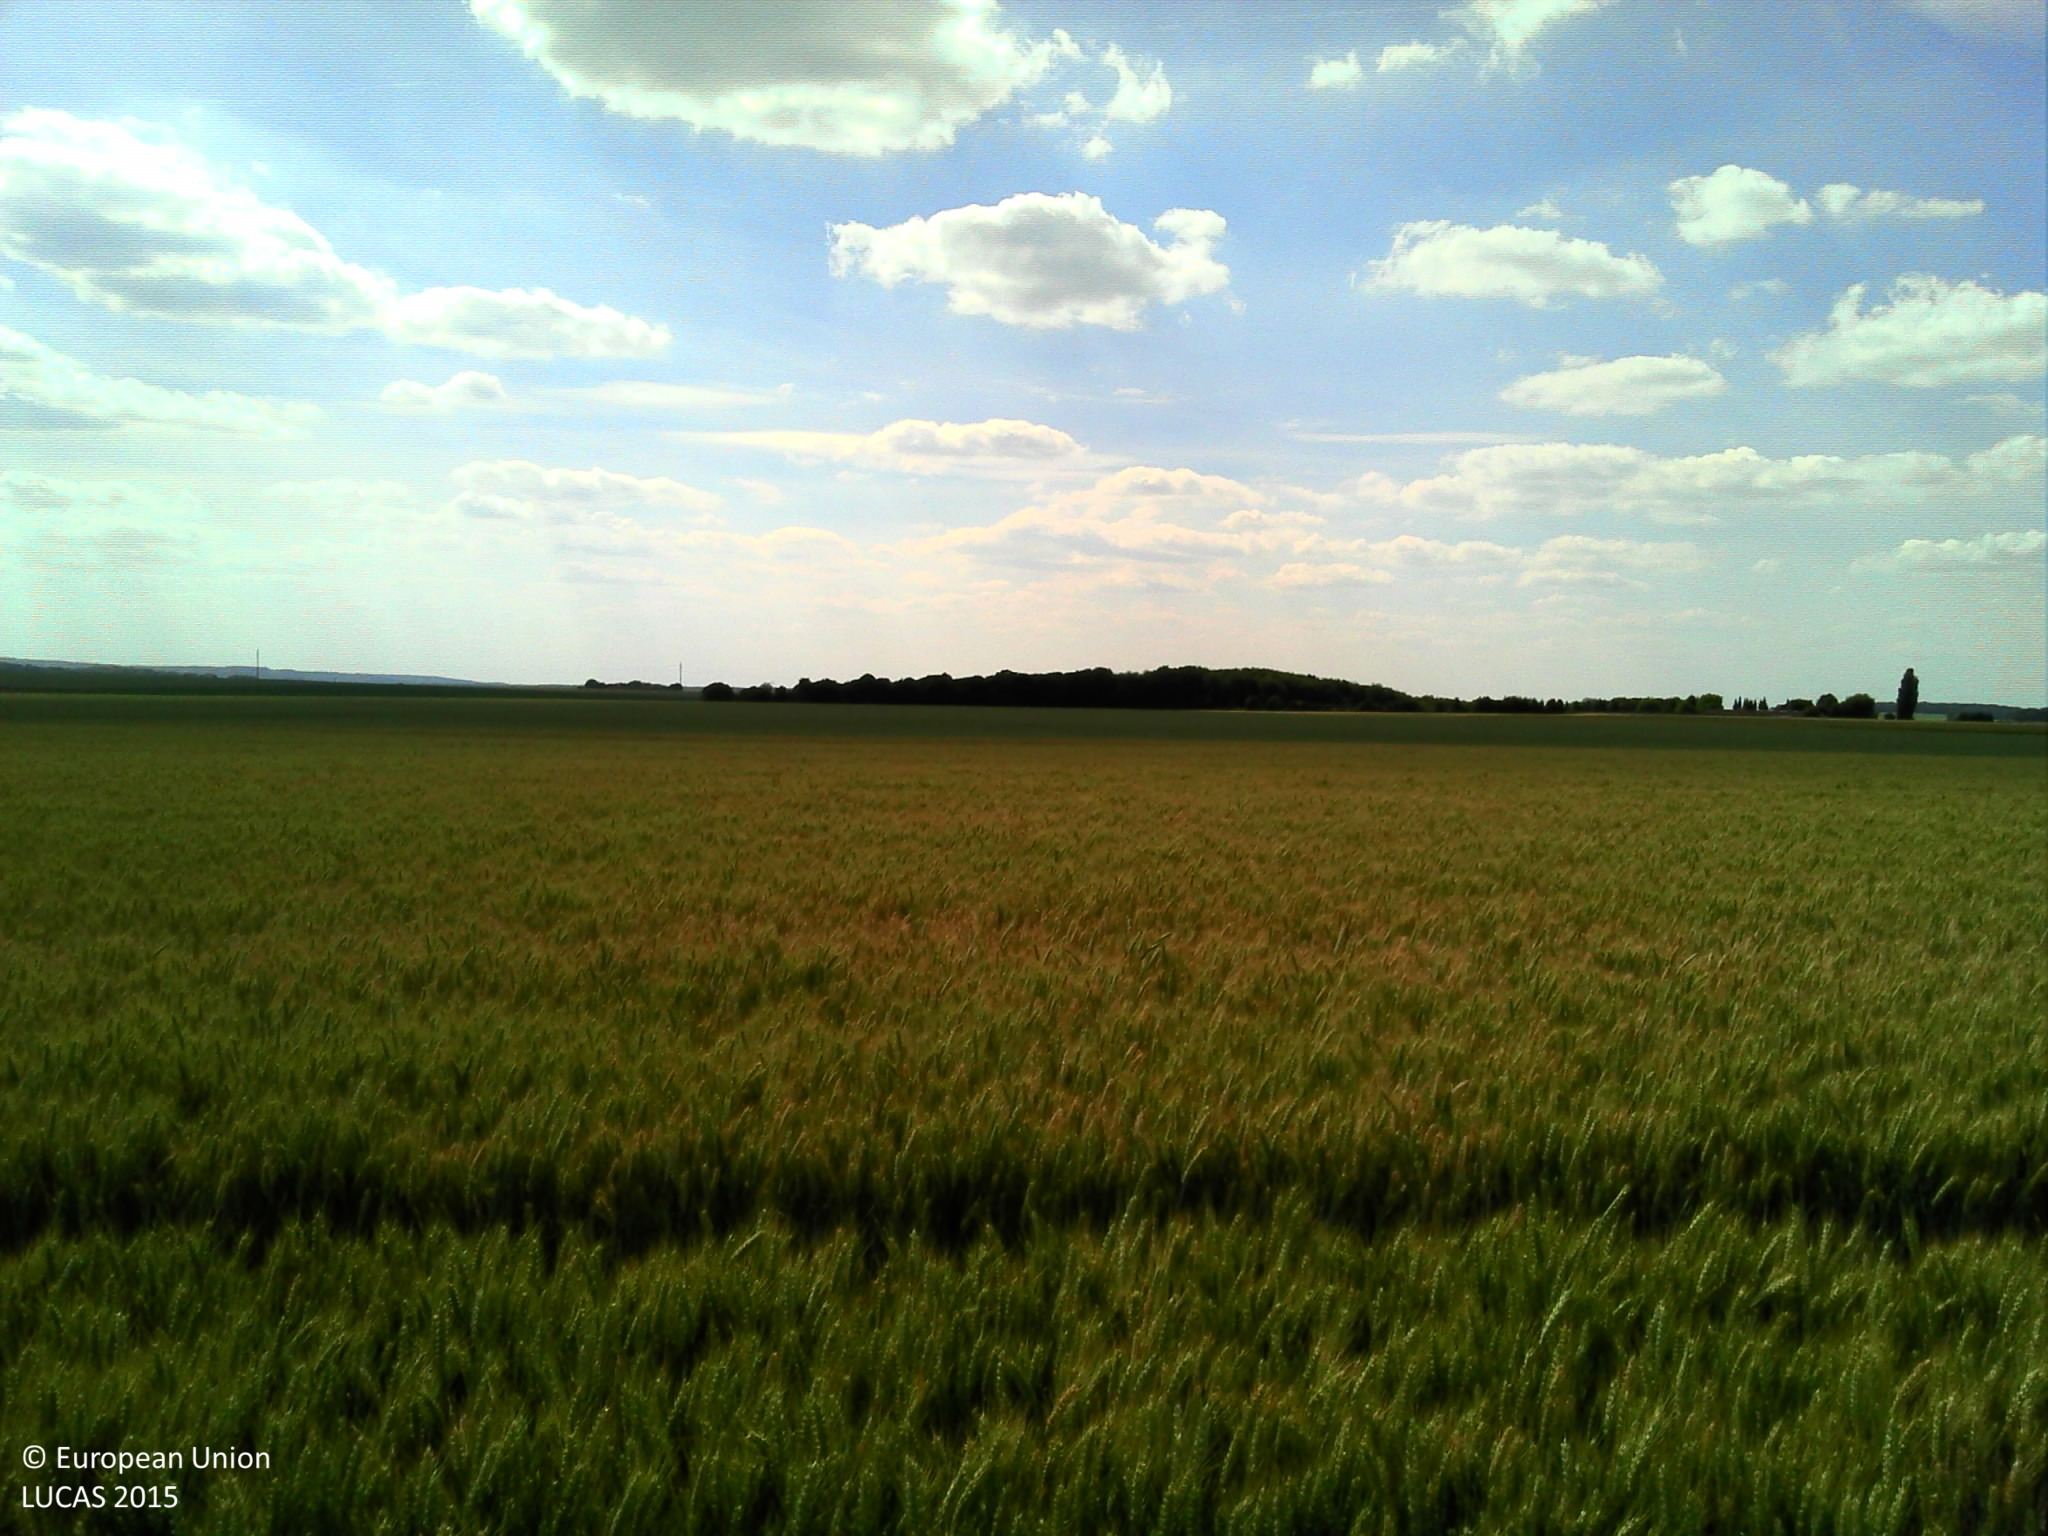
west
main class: Cropland
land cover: Common wheat
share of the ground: > 75 %
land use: Agriculture (excluding fallow land and kitchen gardens)
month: June
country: FR
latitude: 49.3974
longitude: 2.5338
